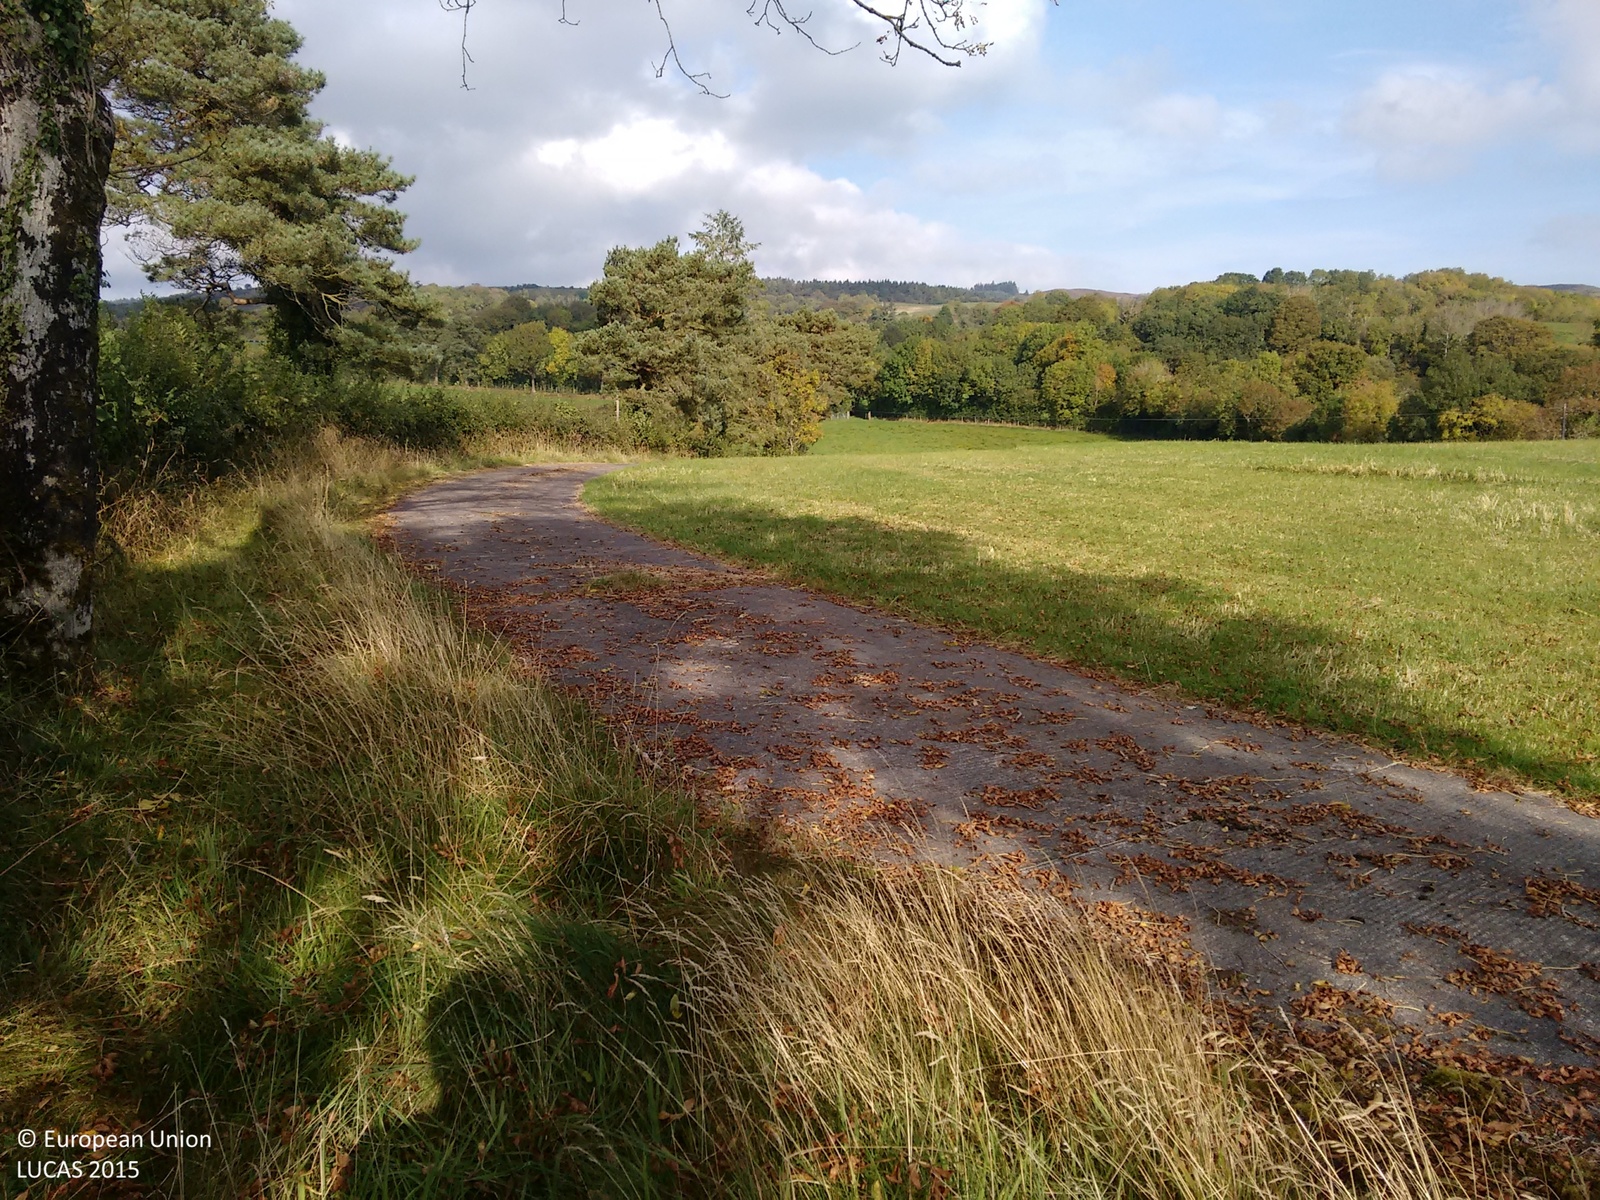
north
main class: Grassland
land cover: Grassland without tree/shrub cover
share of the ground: > 75 %
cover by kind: herbaceous plants 100 %
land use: Agriculture (excluding fallow land and kitchen gardens)
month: October
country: GB
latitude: 54.2963
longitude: -7.8217
